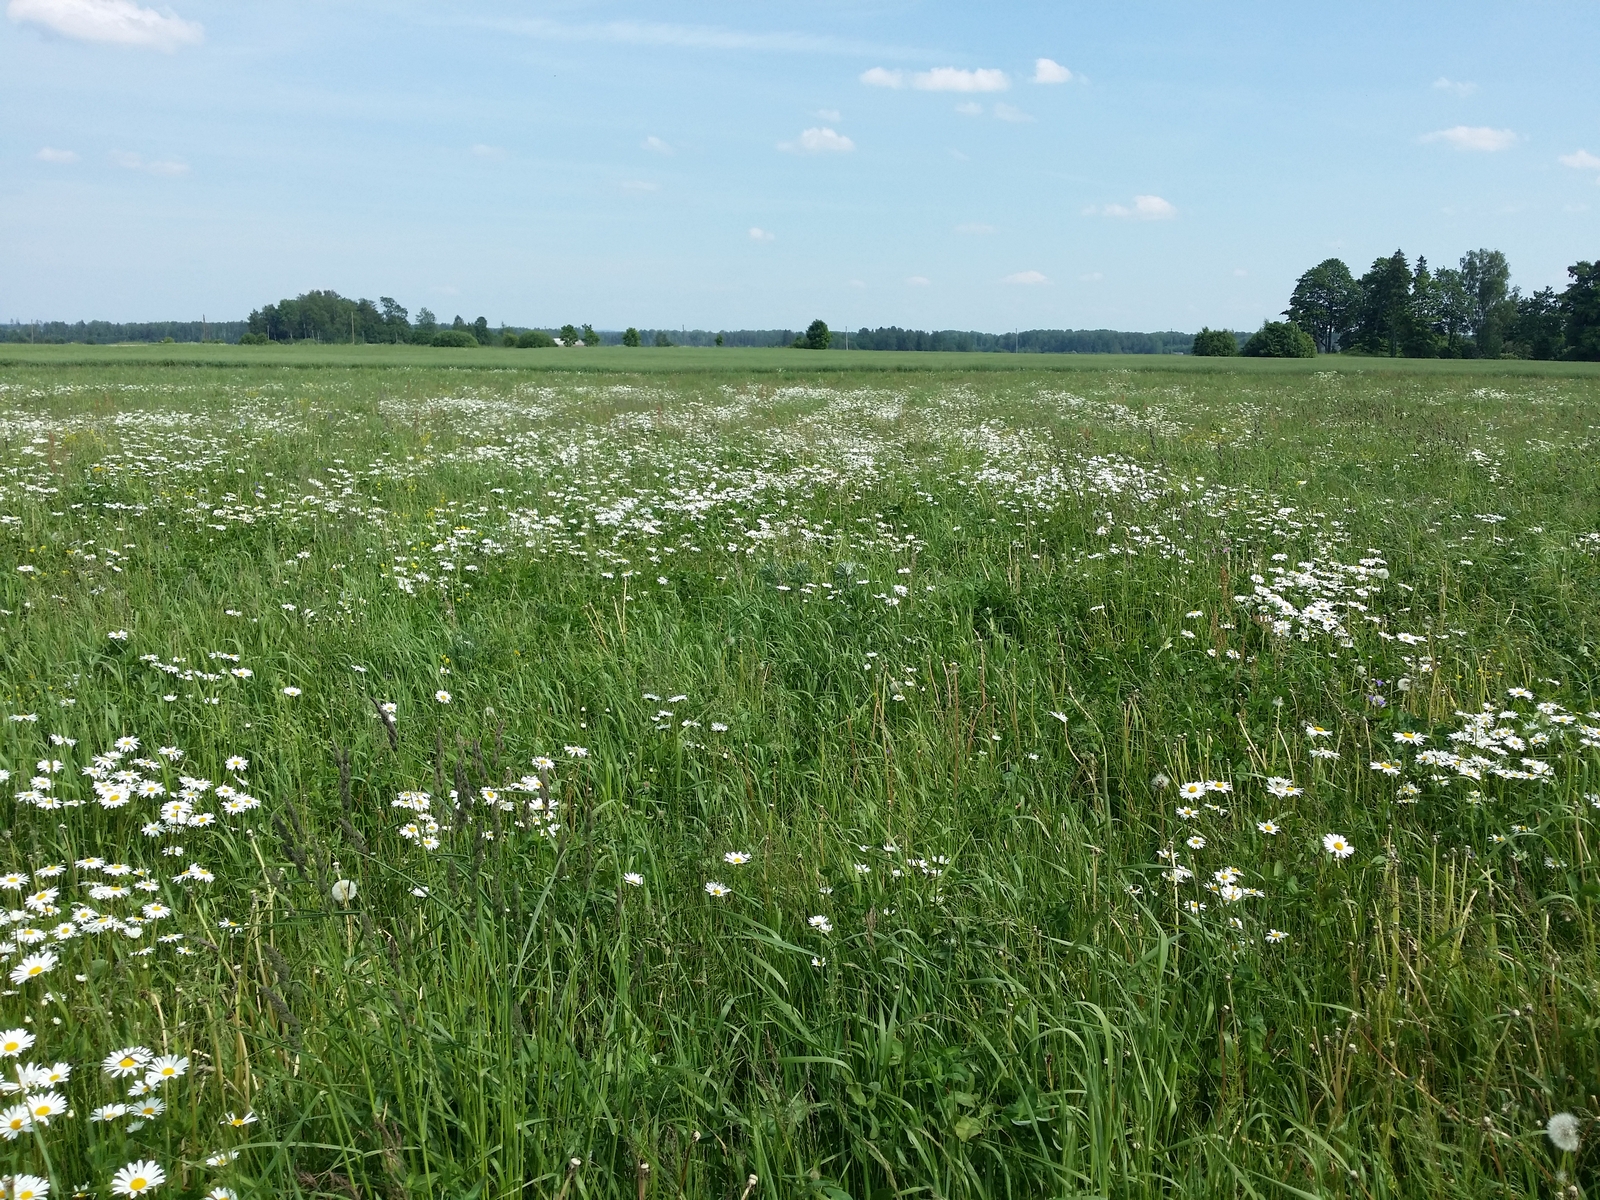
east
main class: Grassland
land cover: Grassland without tree/shrub cover
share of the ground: > 75 %
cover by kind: herbaceous plants 100 %
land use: Agriculture (excluding fallow land and kitchen gardens)
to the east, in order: Grassland without tree/shrub cover; Common wheat
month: June
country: LV
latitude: 57.4354
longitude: 26.5868
